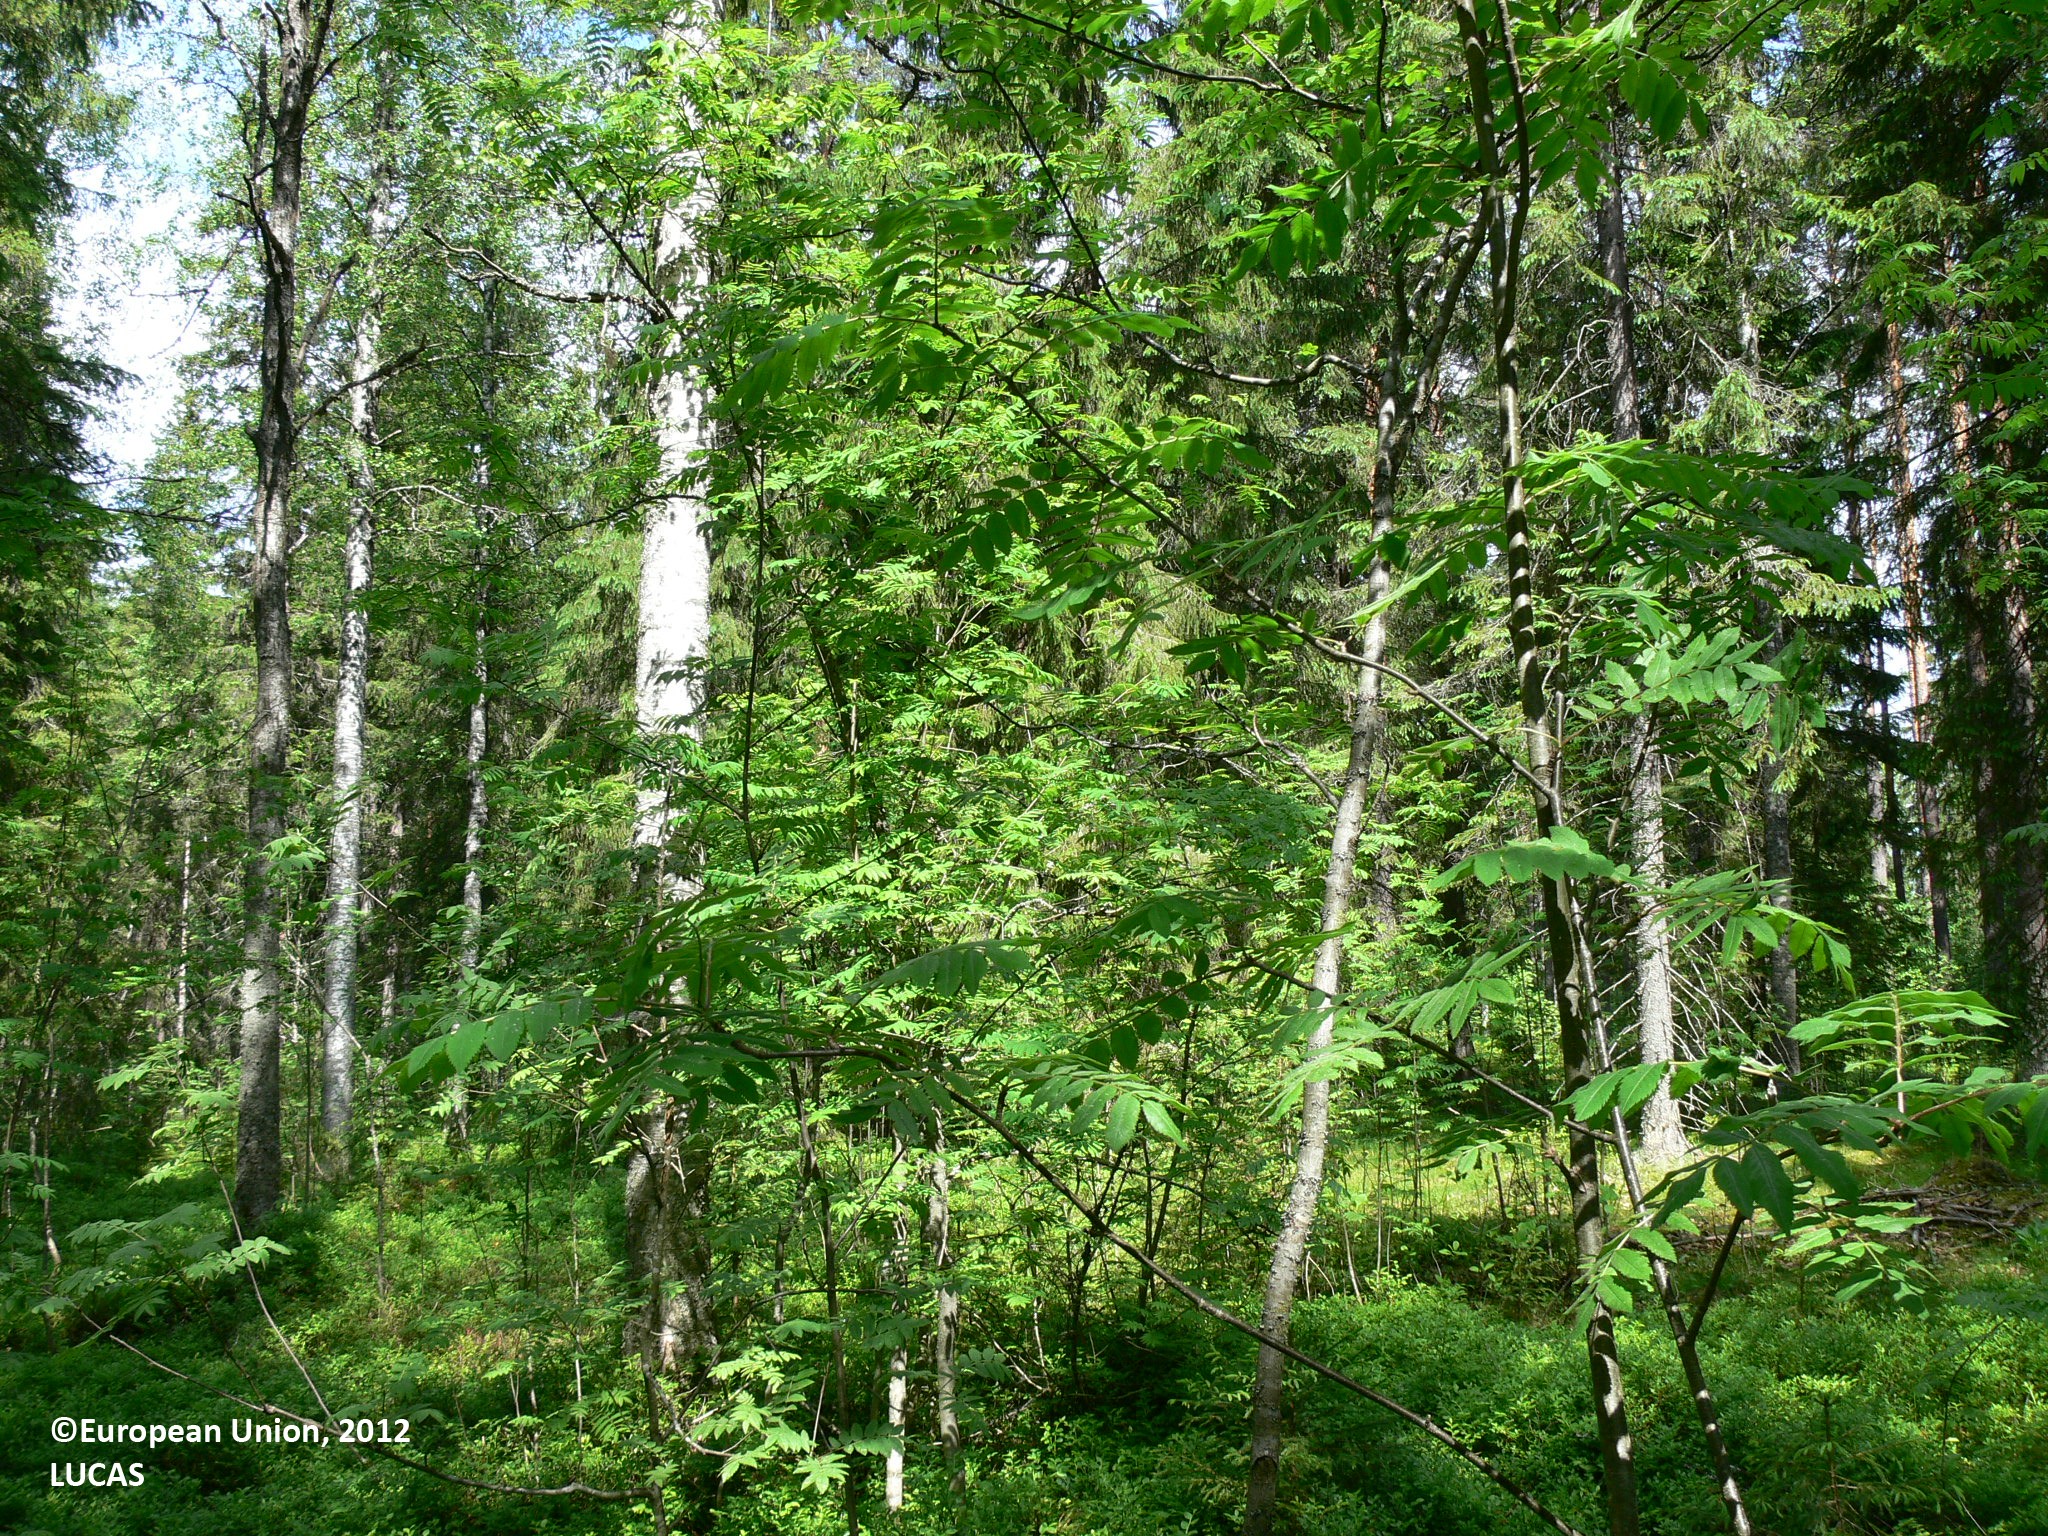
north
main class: Woodland
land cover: Spruce dominated mixed woodland
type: boreal forest
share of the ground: > 75 %
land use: Forestry
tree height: > 5 m
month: June
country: FI
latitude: 62.8158
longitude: 29.8919
